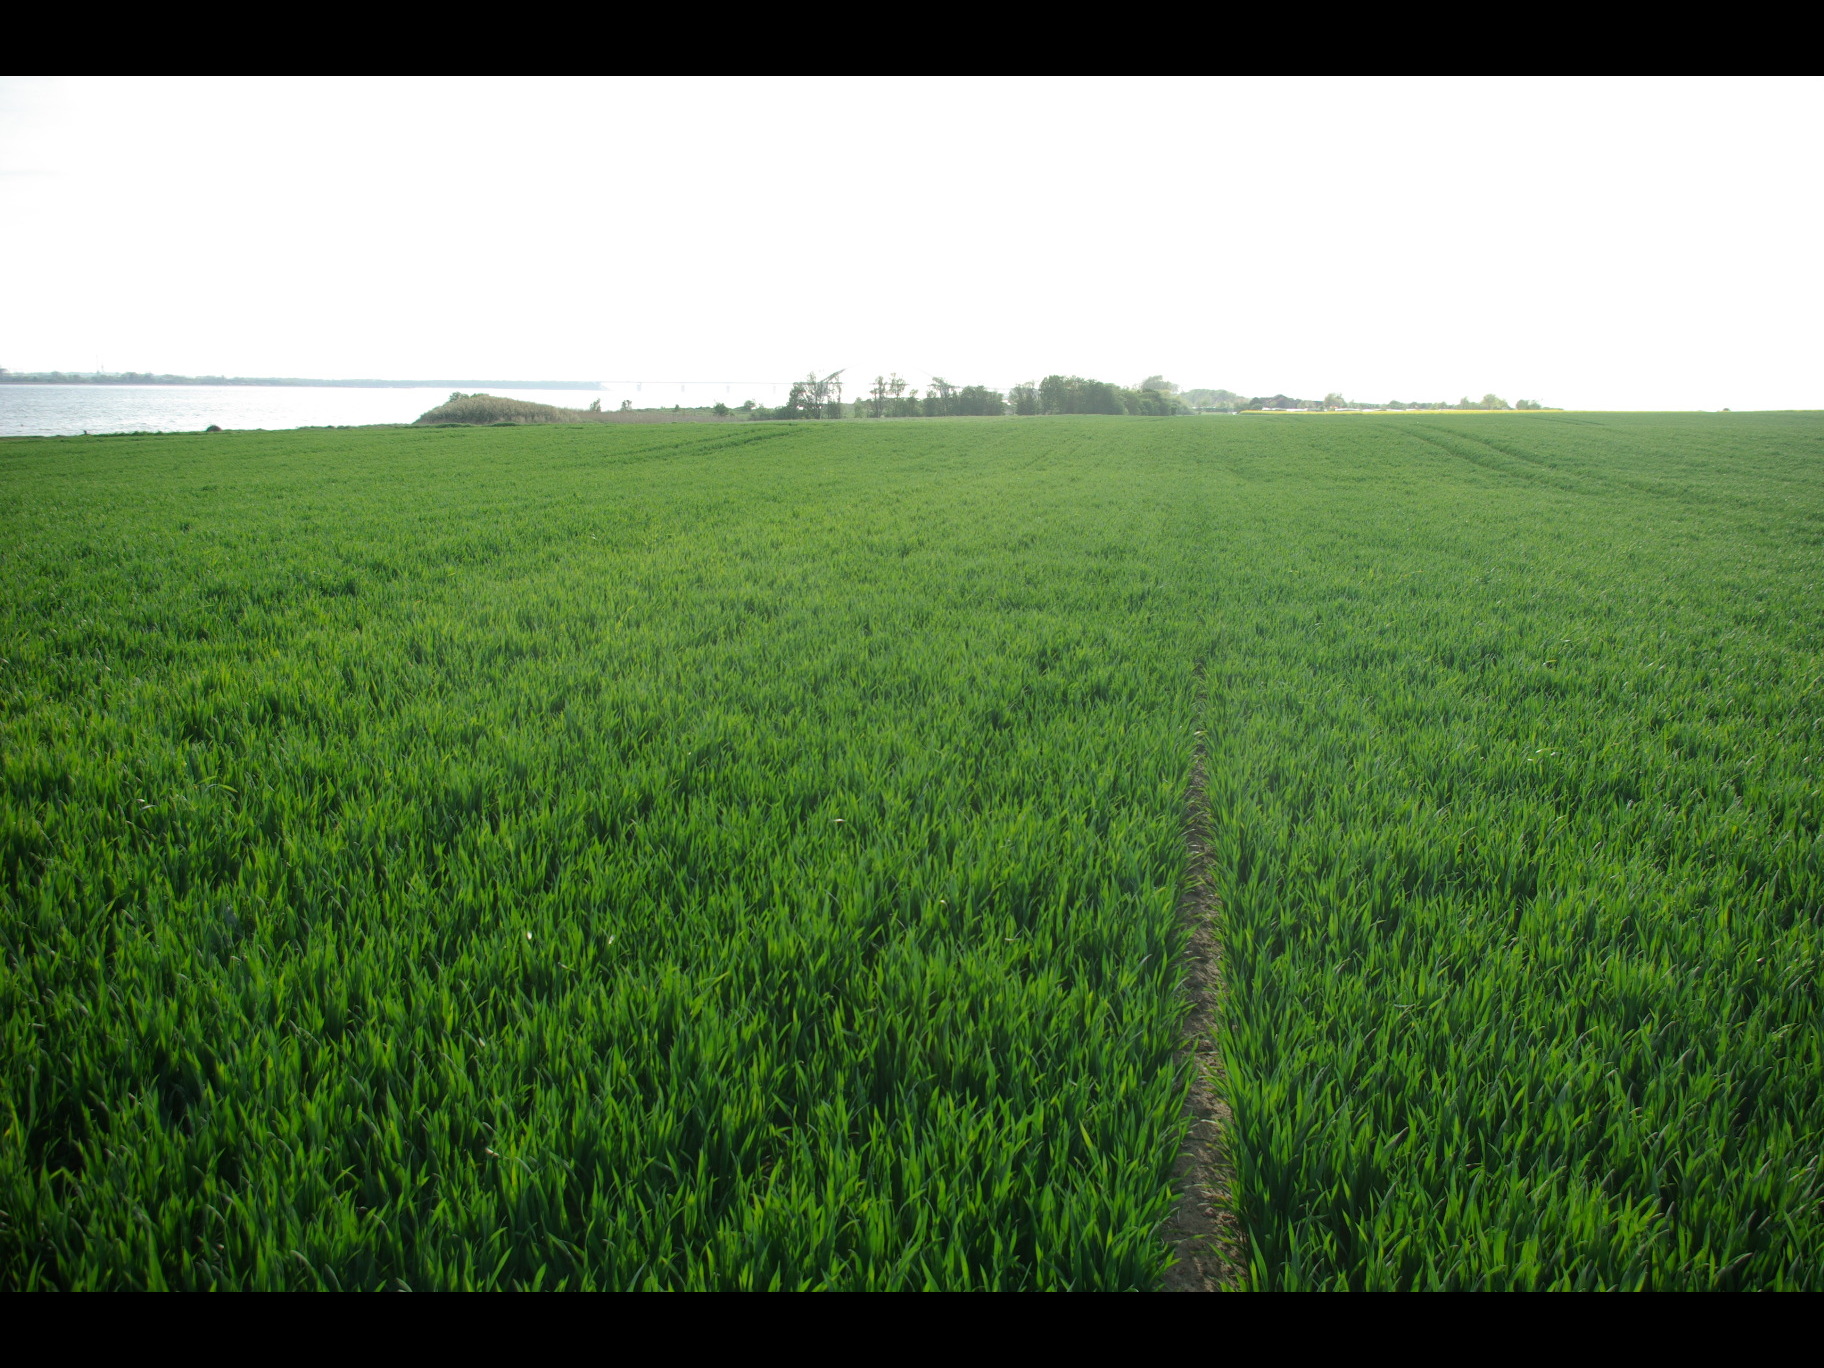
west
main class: Cropland
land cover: Common wheat
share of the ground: > 75 %
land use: Agriculture (excluding fallow land and kitchen gardens)
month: May
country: DE
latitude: 54.4030
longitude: 11.1547
